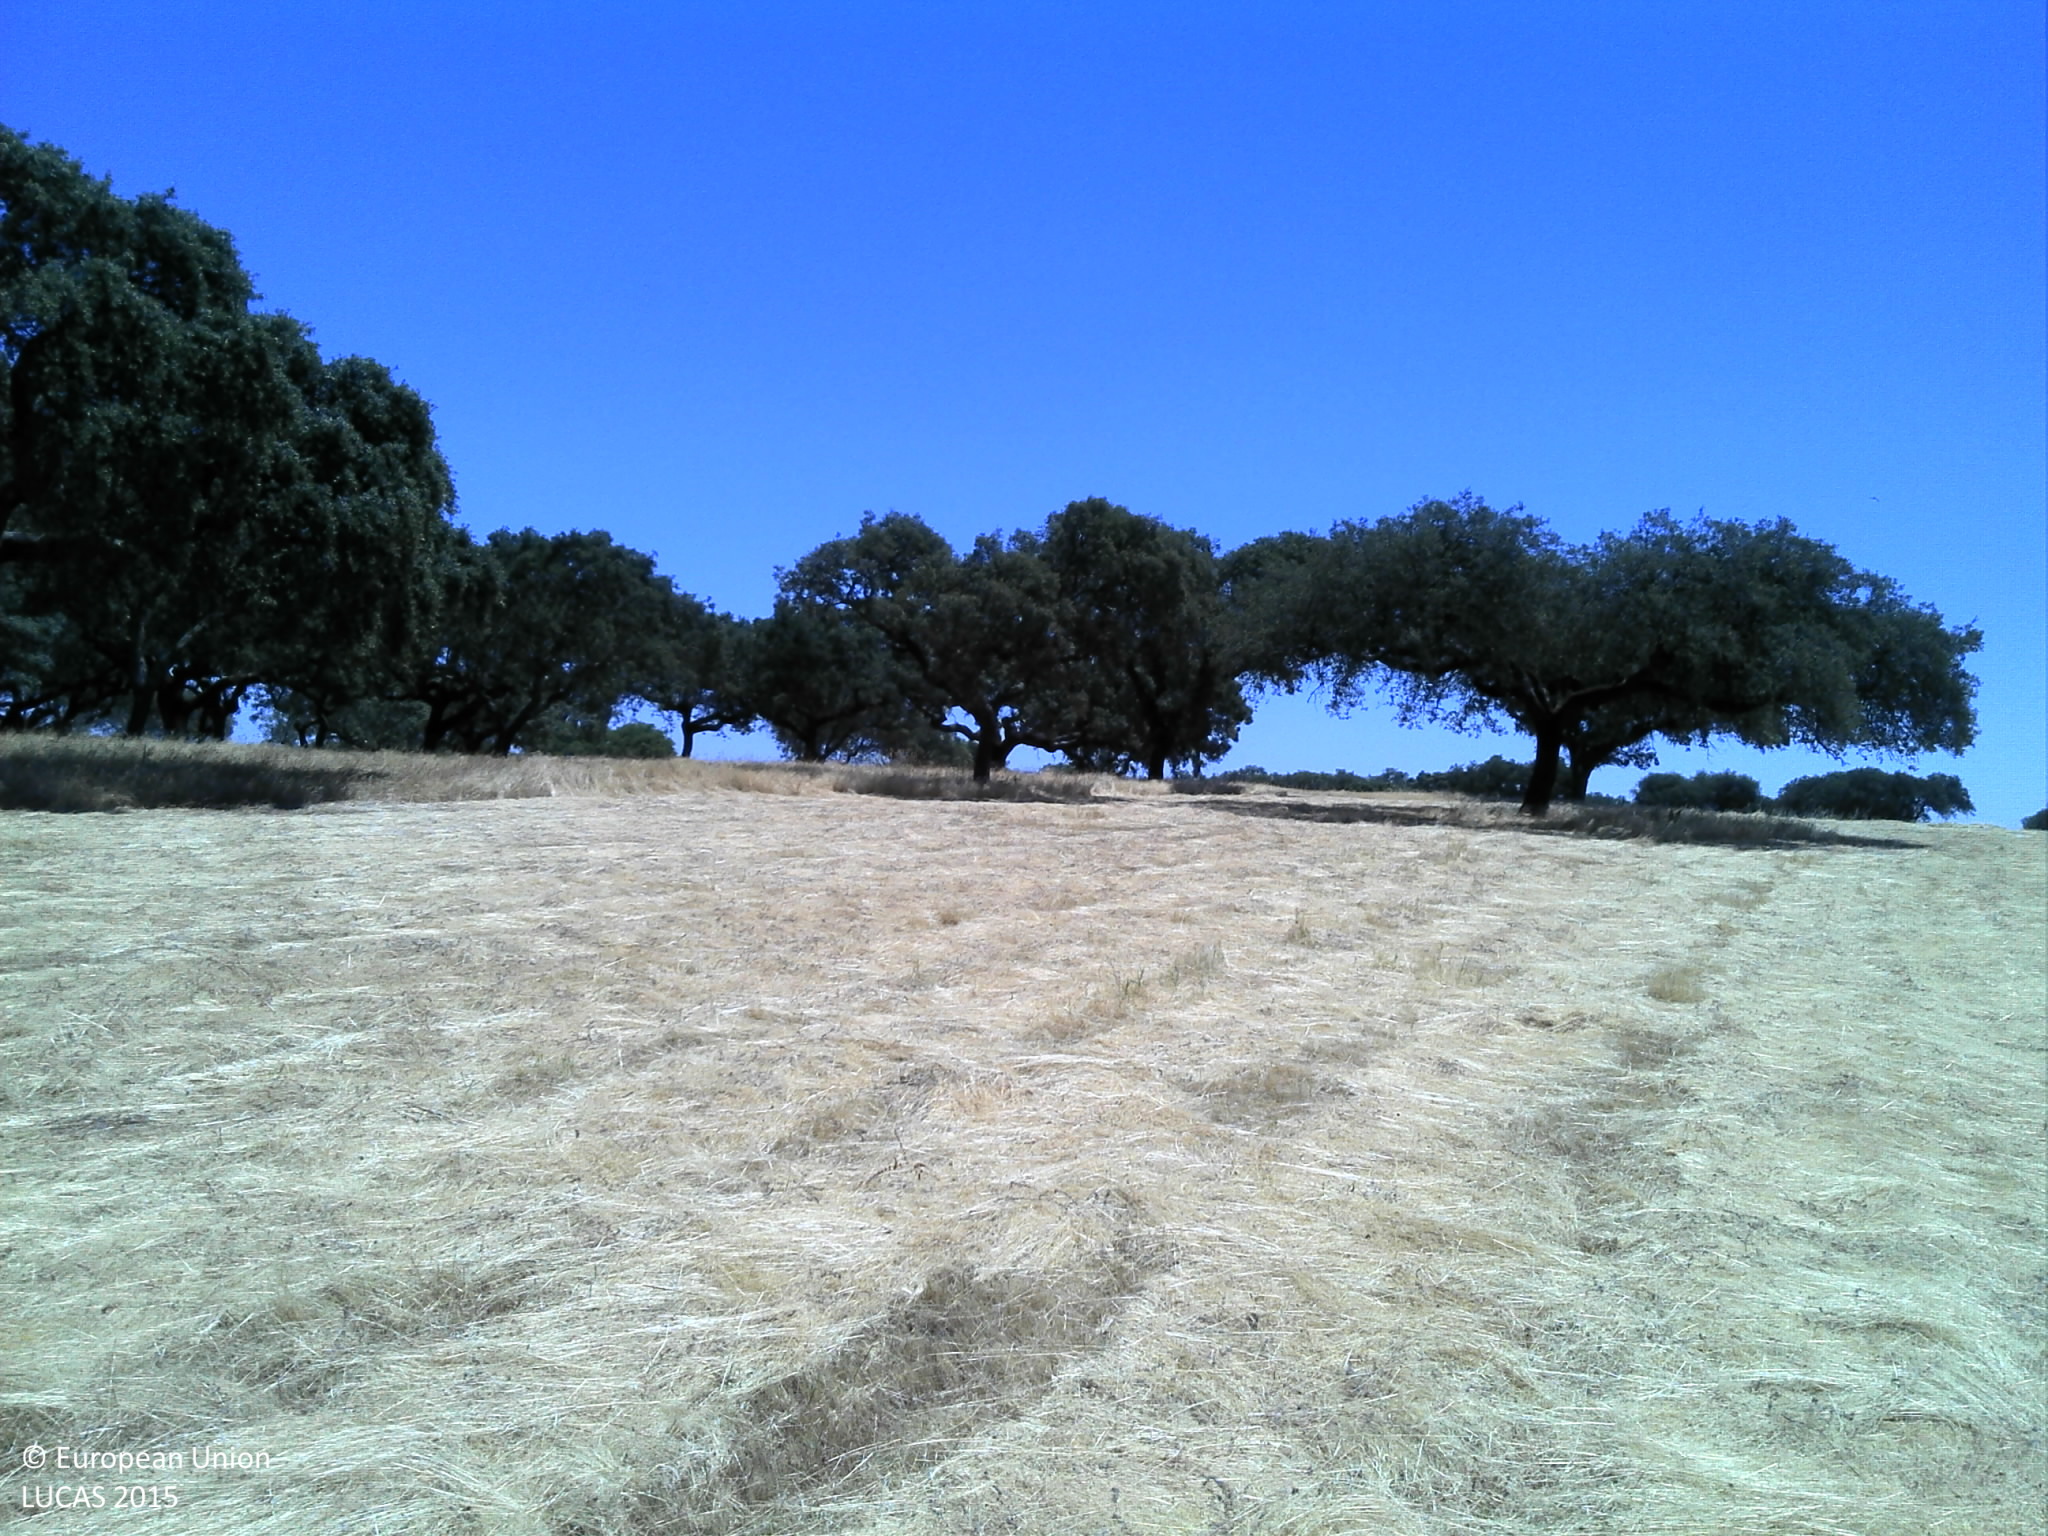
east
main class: Woodland
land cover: Broadleaved woodland
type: broadleaved evergreen forest
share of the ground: 10 - 25 %
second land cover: Grassland without tree/shrub cover
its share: 50 - 75 %
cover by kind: herbaceous plants 75 %, unconsolidated bare surface 15 %, broadleaved forest trees 10 %
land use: Forestry
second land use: Agriculture (excluding fallow land and kitchen gardens)
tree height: > 5 m
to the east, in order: Broadleaved woodland; Grassland without tree/shrub cover; Broadleaved woodland; Tracks; Broadleaved woodland; Grassland without tree/shrub cover; Fences; Broadleaved woodland
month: June
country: PT
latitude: 38.7135
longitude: -8.2089
